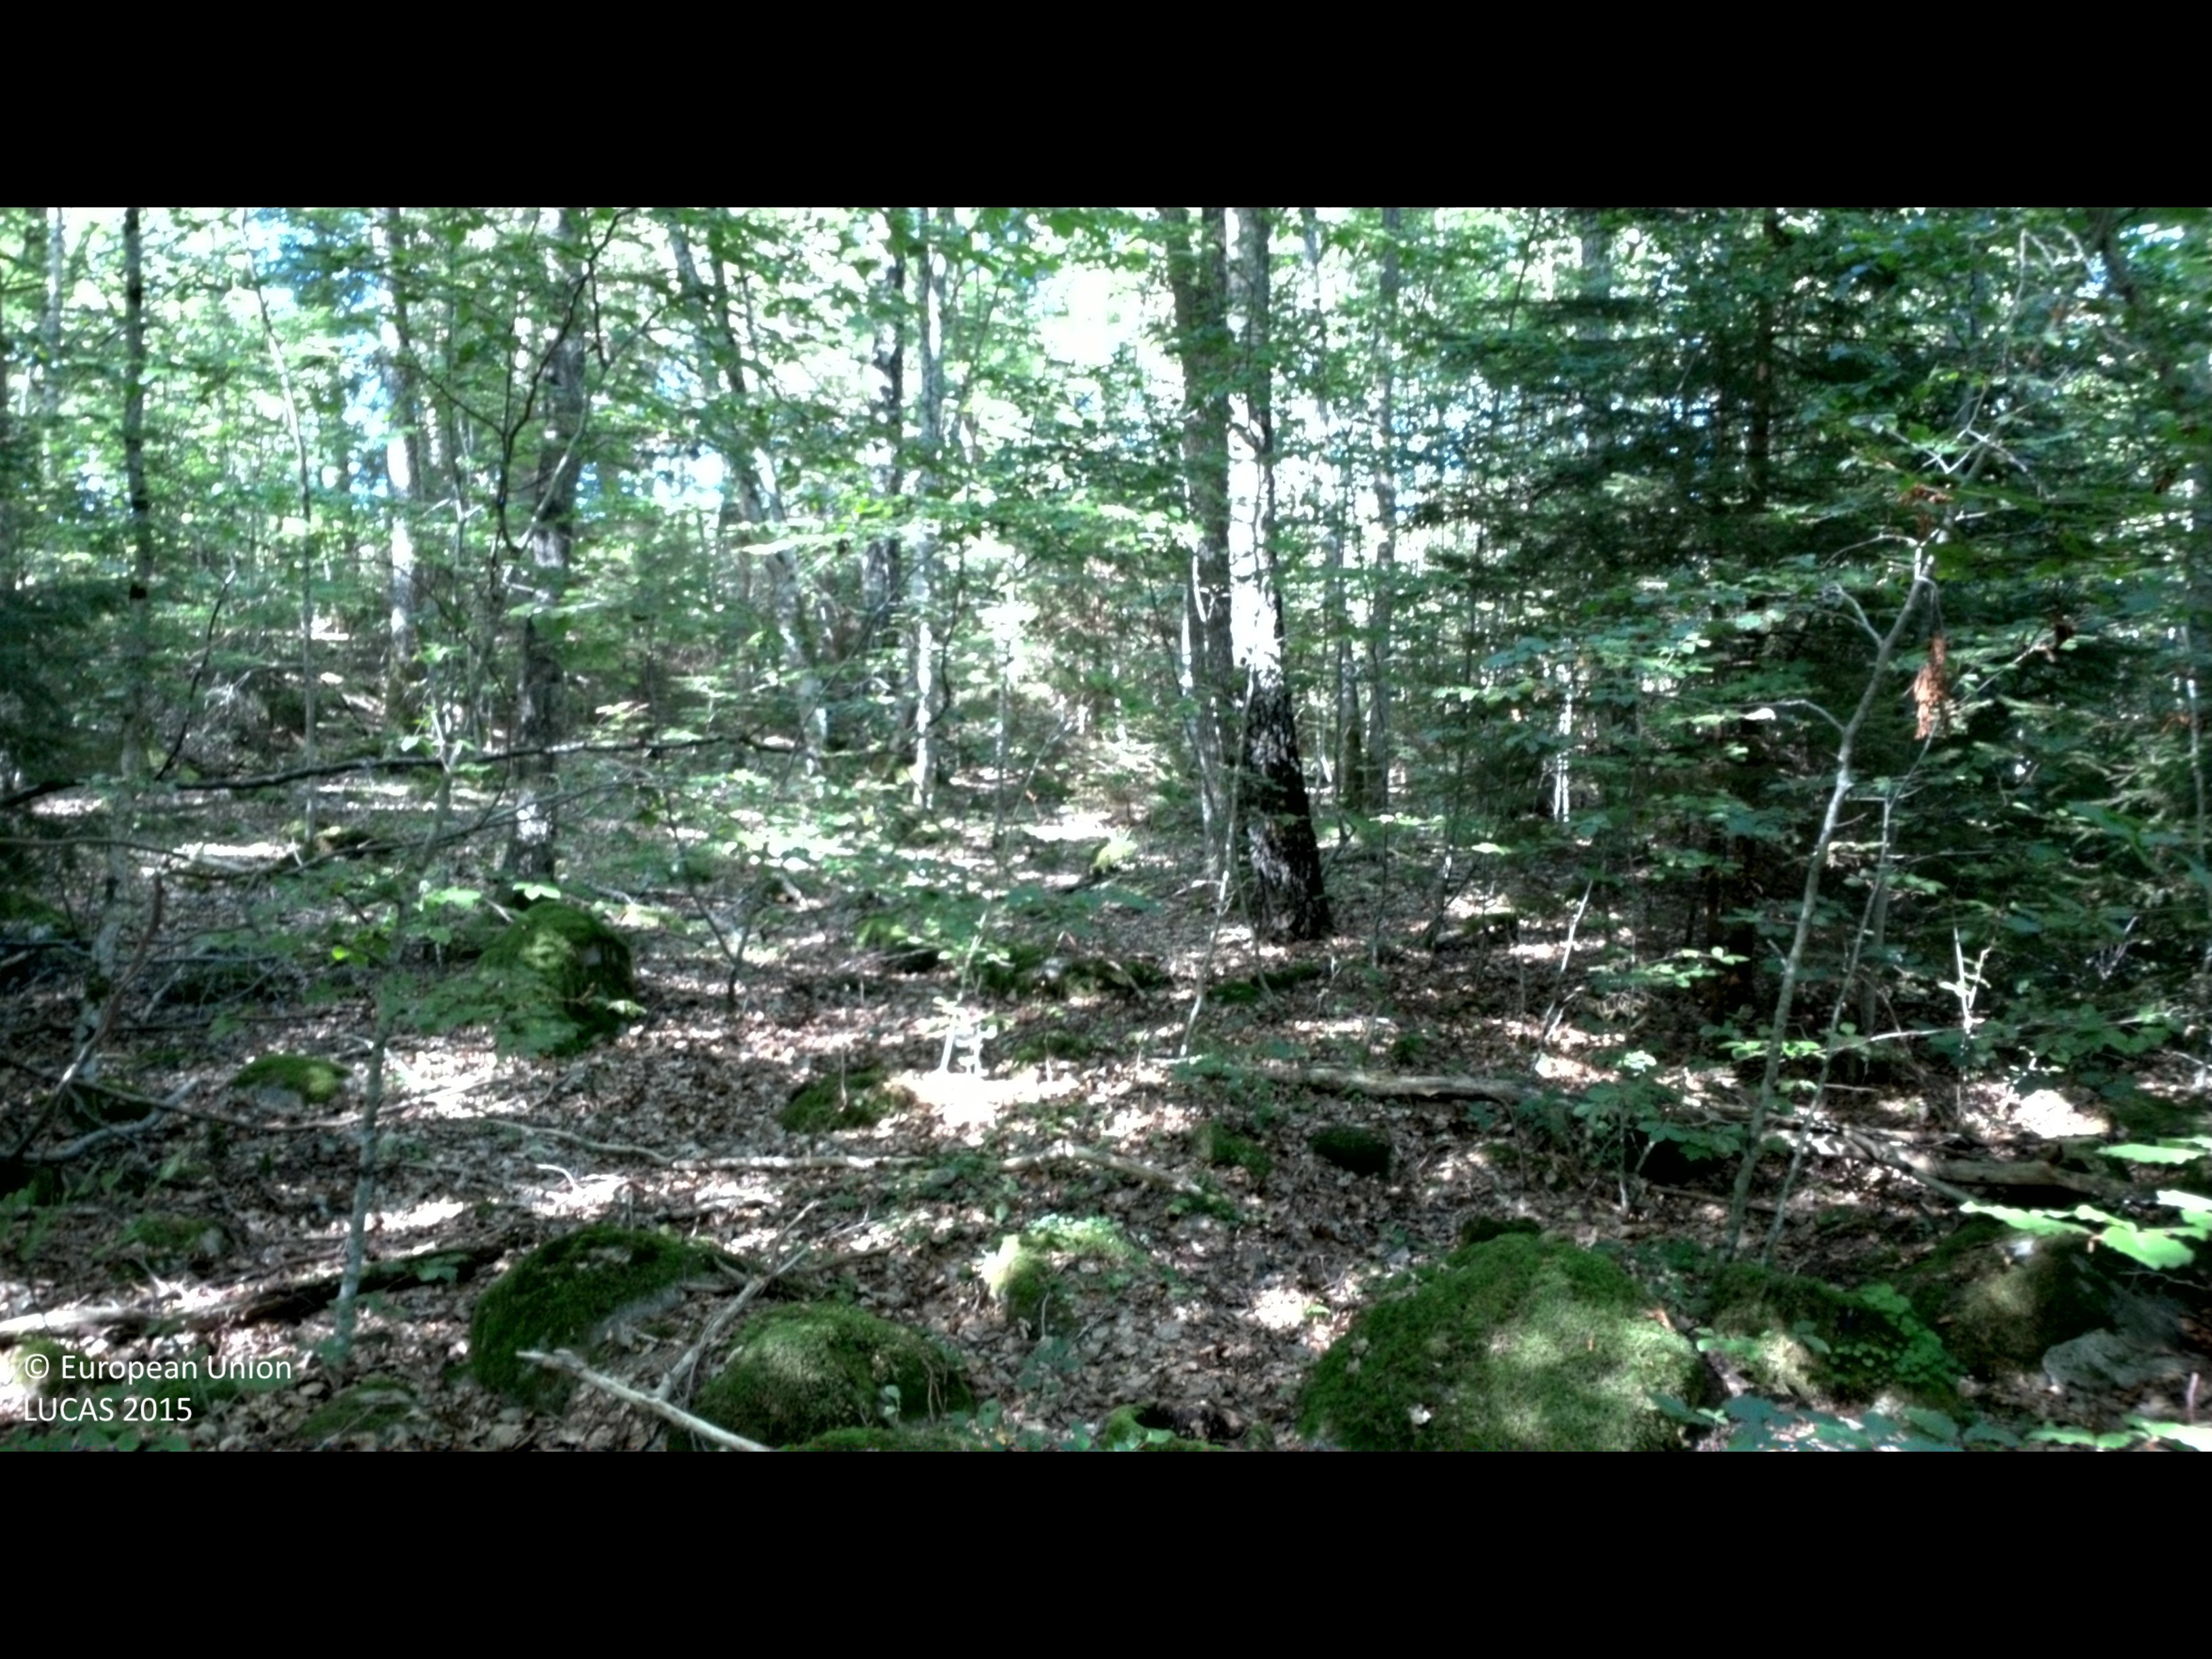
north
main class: Woodland
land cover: Broadleaved woodland
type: beech forest
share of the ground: > 75 %
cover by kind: broadleaved forest trees 75 %, coniferous forest trees 5 %, herbaceous plants 5 %
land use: Forestry
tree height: > 5 m
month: August
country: SE
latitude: 56.2640
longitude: 14.6963
